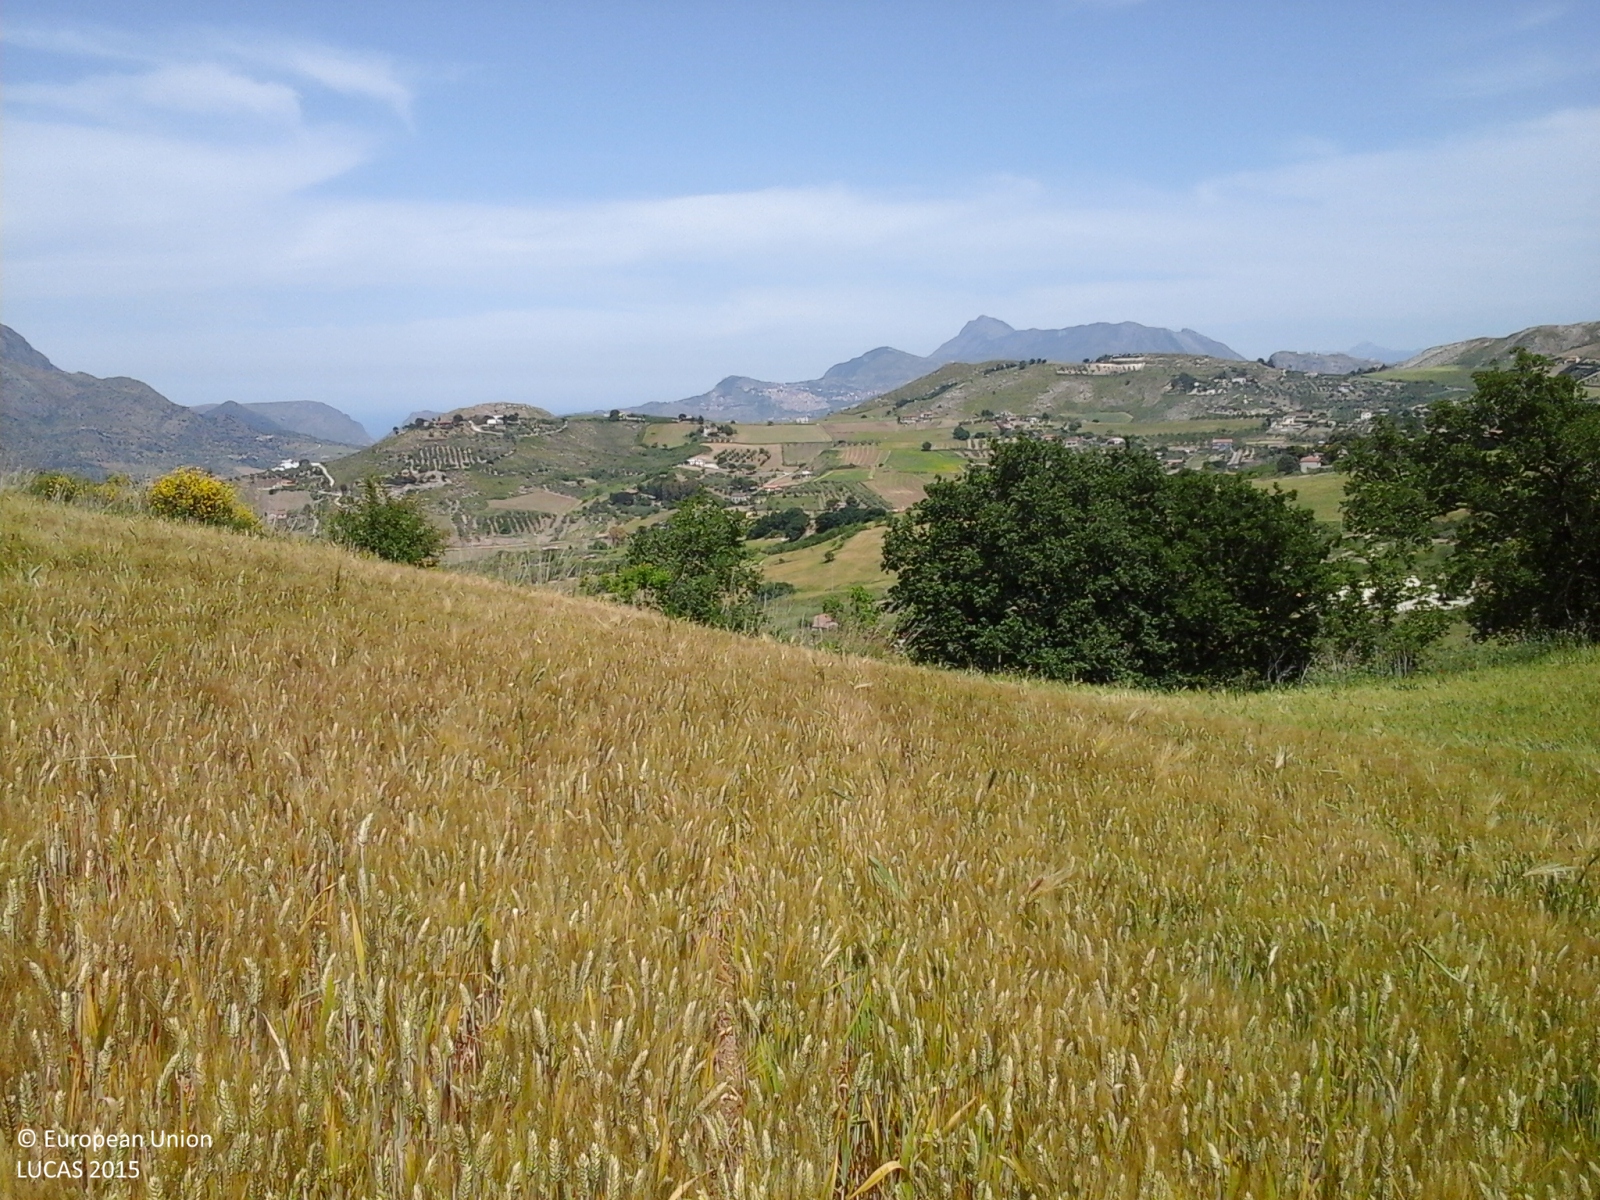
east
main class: Cropland
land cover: Durum wheat
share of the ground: > 75 %
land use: Agriculture (excluding fallow land and kitchen gardens)
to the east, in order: Durum wheat; Broadleaved woodland; Grassland with sparse tree/shrub cover; Arable land (only in case pi); Permanent crops (only in case pi); Arable land (only in case pi)
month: May
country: IT
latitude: 37.8809
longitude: 13.5558
